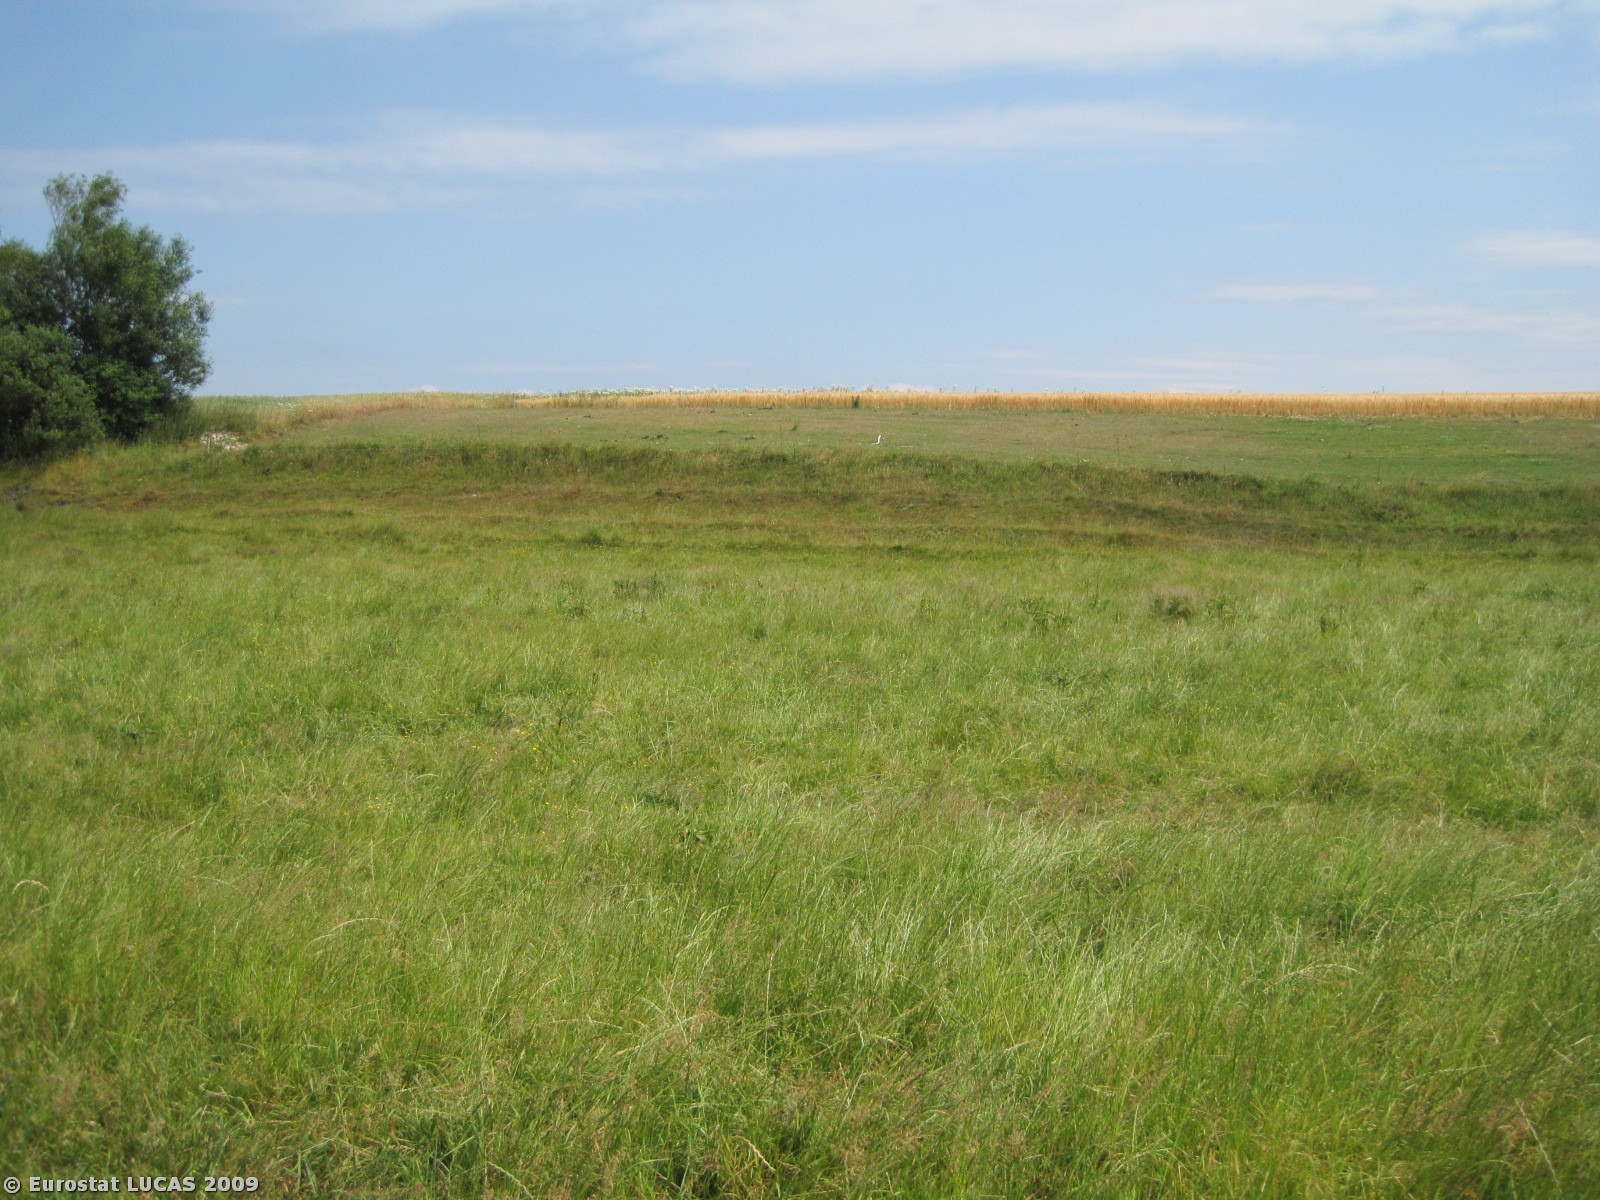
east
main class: Grassland
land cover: Grassland without tree/shrub cover
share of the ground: > 75 %
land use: Agriculture (excluding fallow land and kitchen gardens)
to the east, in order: Grassland without tree/shrub cover; Fences; Grass margins; Ditches and canals; Grass margins; Fences; Grassland without tree/shrub cover; Fences; Grass margins; Fences; Grassland without tree/shrub cover; Fences; Grass margins; Barley; Grass margins; Common wheat; Grass margins; Barley
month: June
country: DK
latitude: 56.5017
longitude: 8.4261
